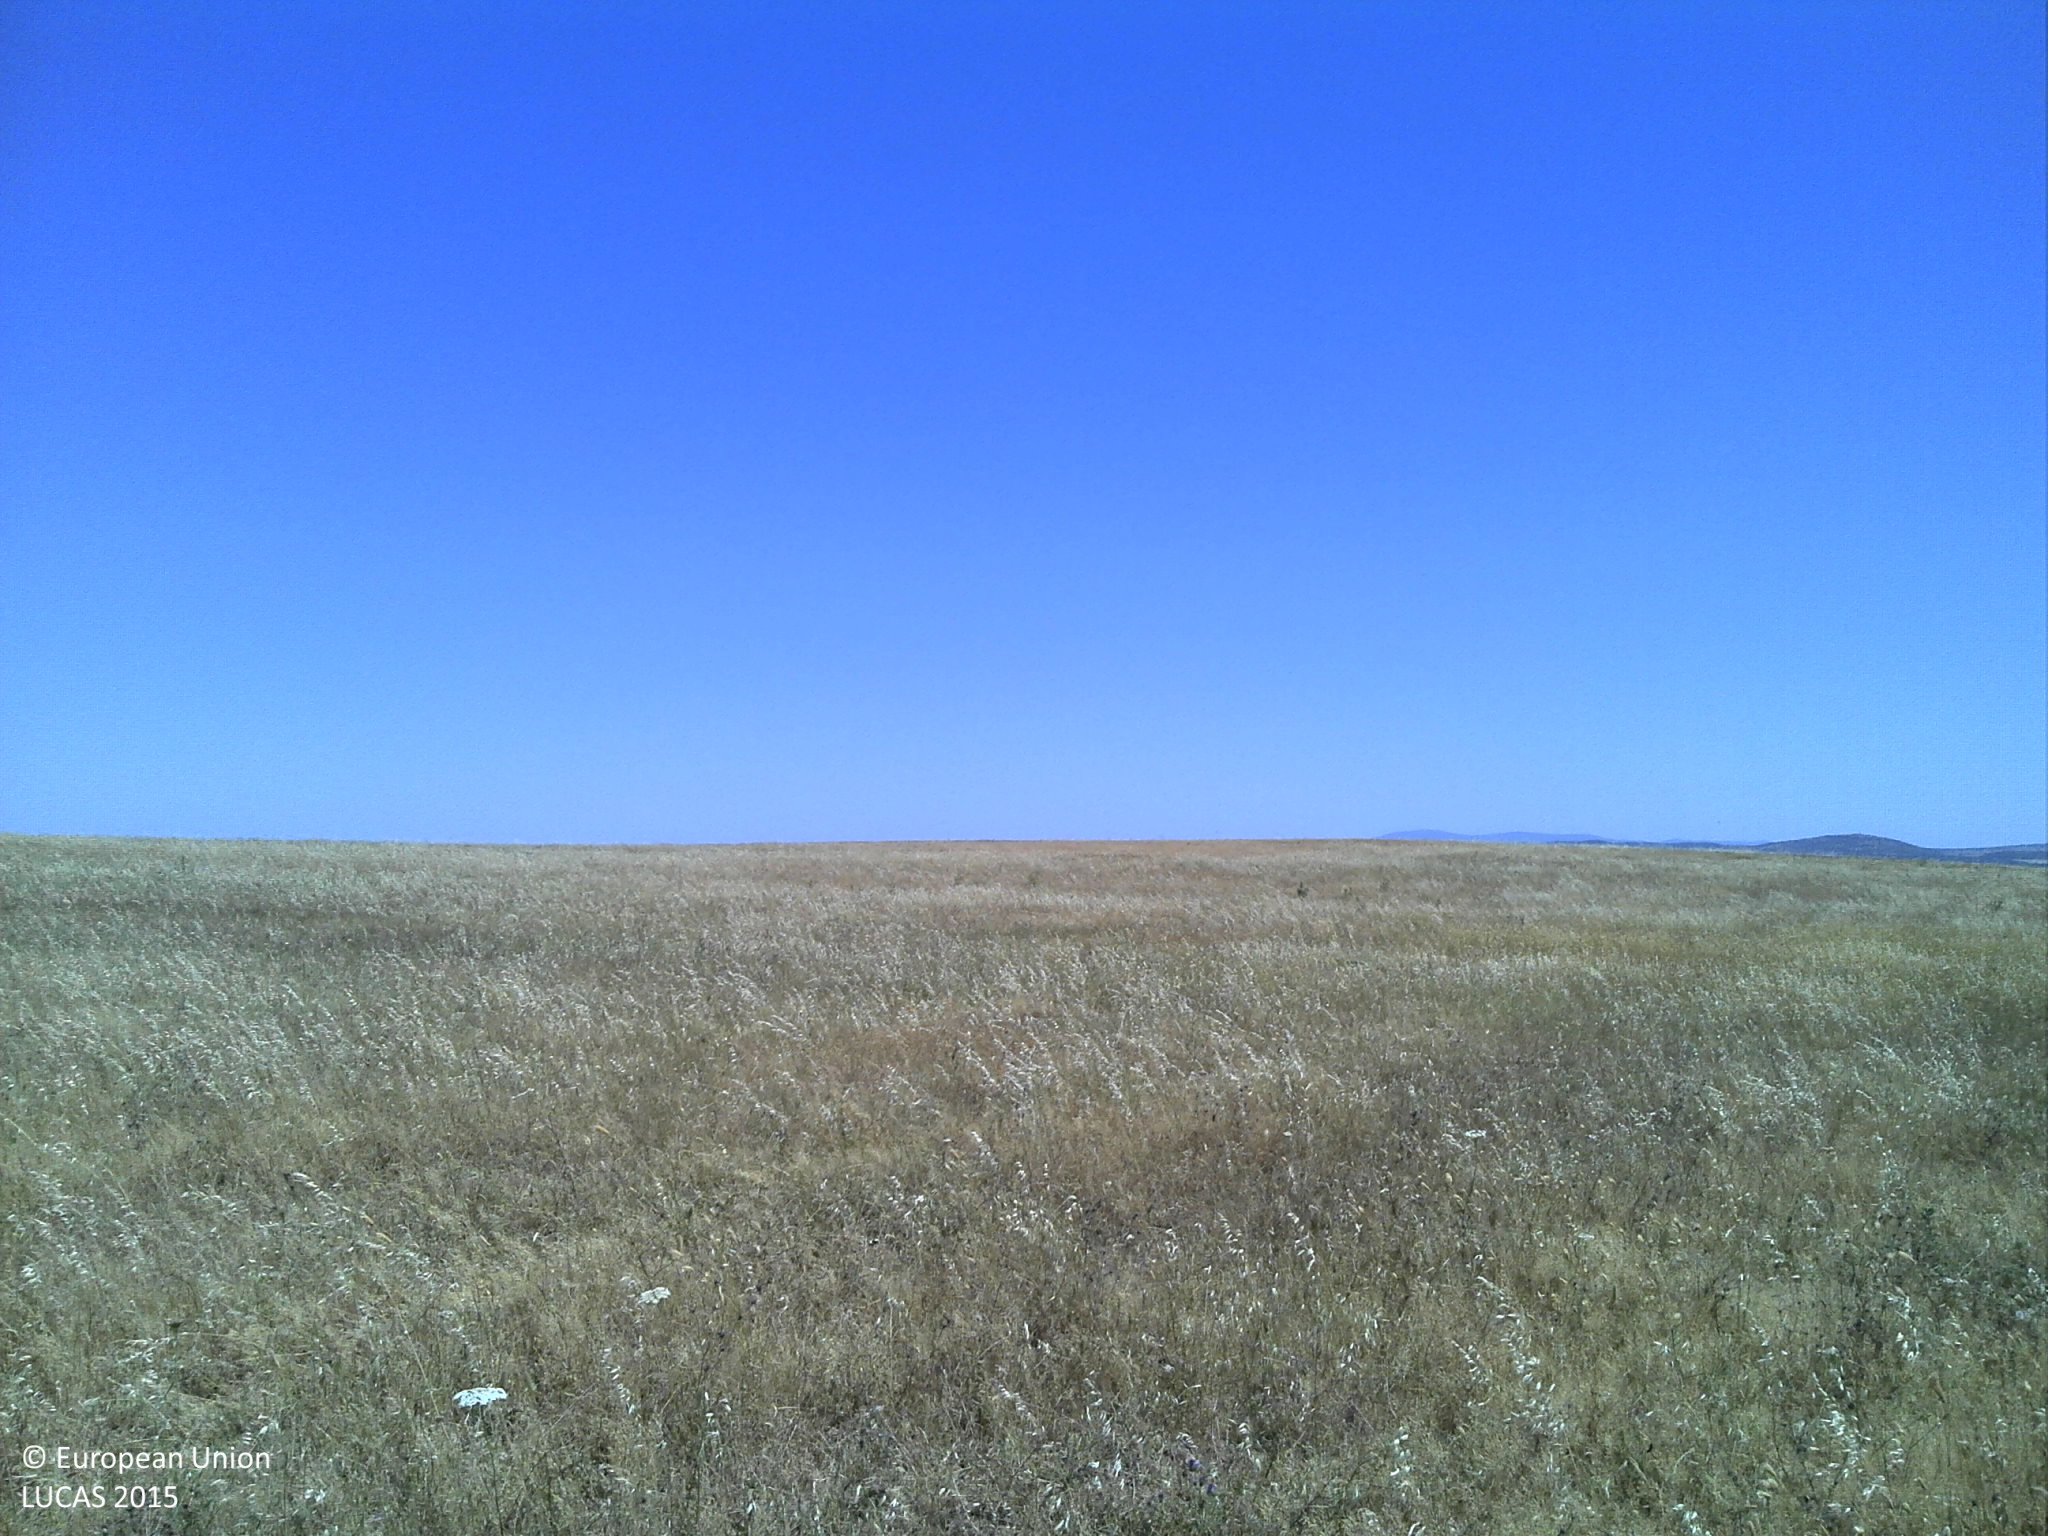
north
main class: Grassland
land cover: Grassland without tree/shrub cover
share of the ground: > 75 %
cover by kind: herbaceous plants 80 %, unconsolidated bare surface 20 %
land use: Agriculture (excluding fallow land and kitchen gardens)
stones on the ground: < 10 %
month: May
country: PT
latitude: 39.0295
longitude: -7.6107
